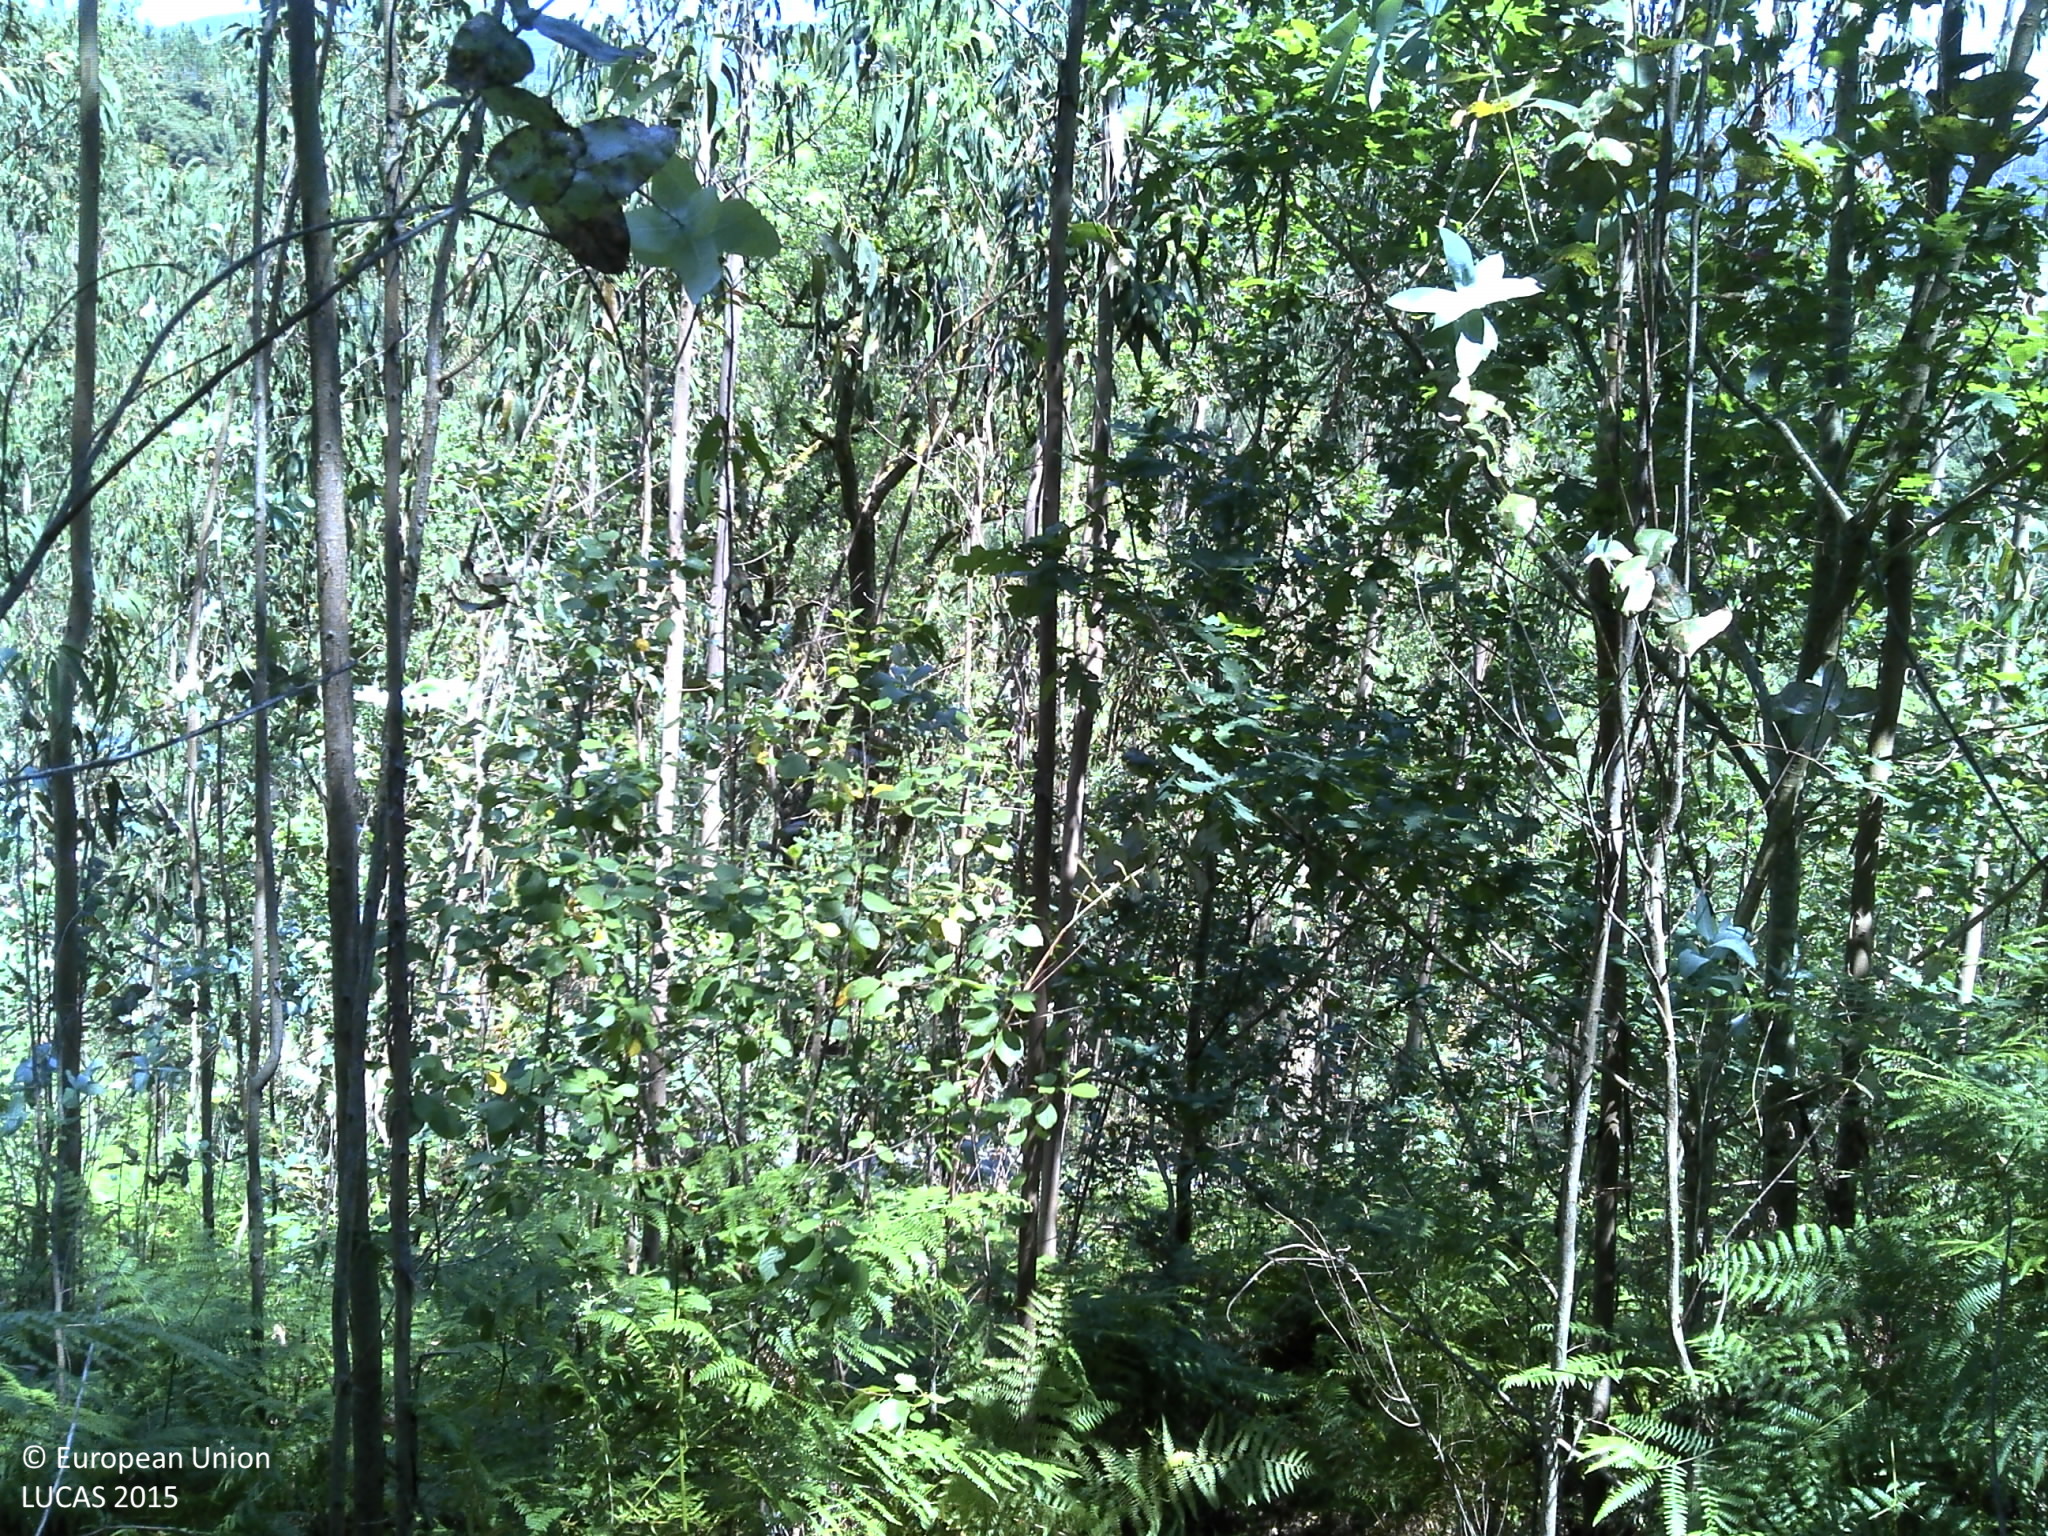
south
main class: Woodland
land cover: Broadleaved woodland
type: exotic forest
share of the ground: 50 - 75 %
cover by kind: broadleaved forest trees 60 %, shrubs 40 %
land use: Forestry
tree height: > 5 m
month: May
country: PT
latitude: 41.8284
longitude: -8.6473
